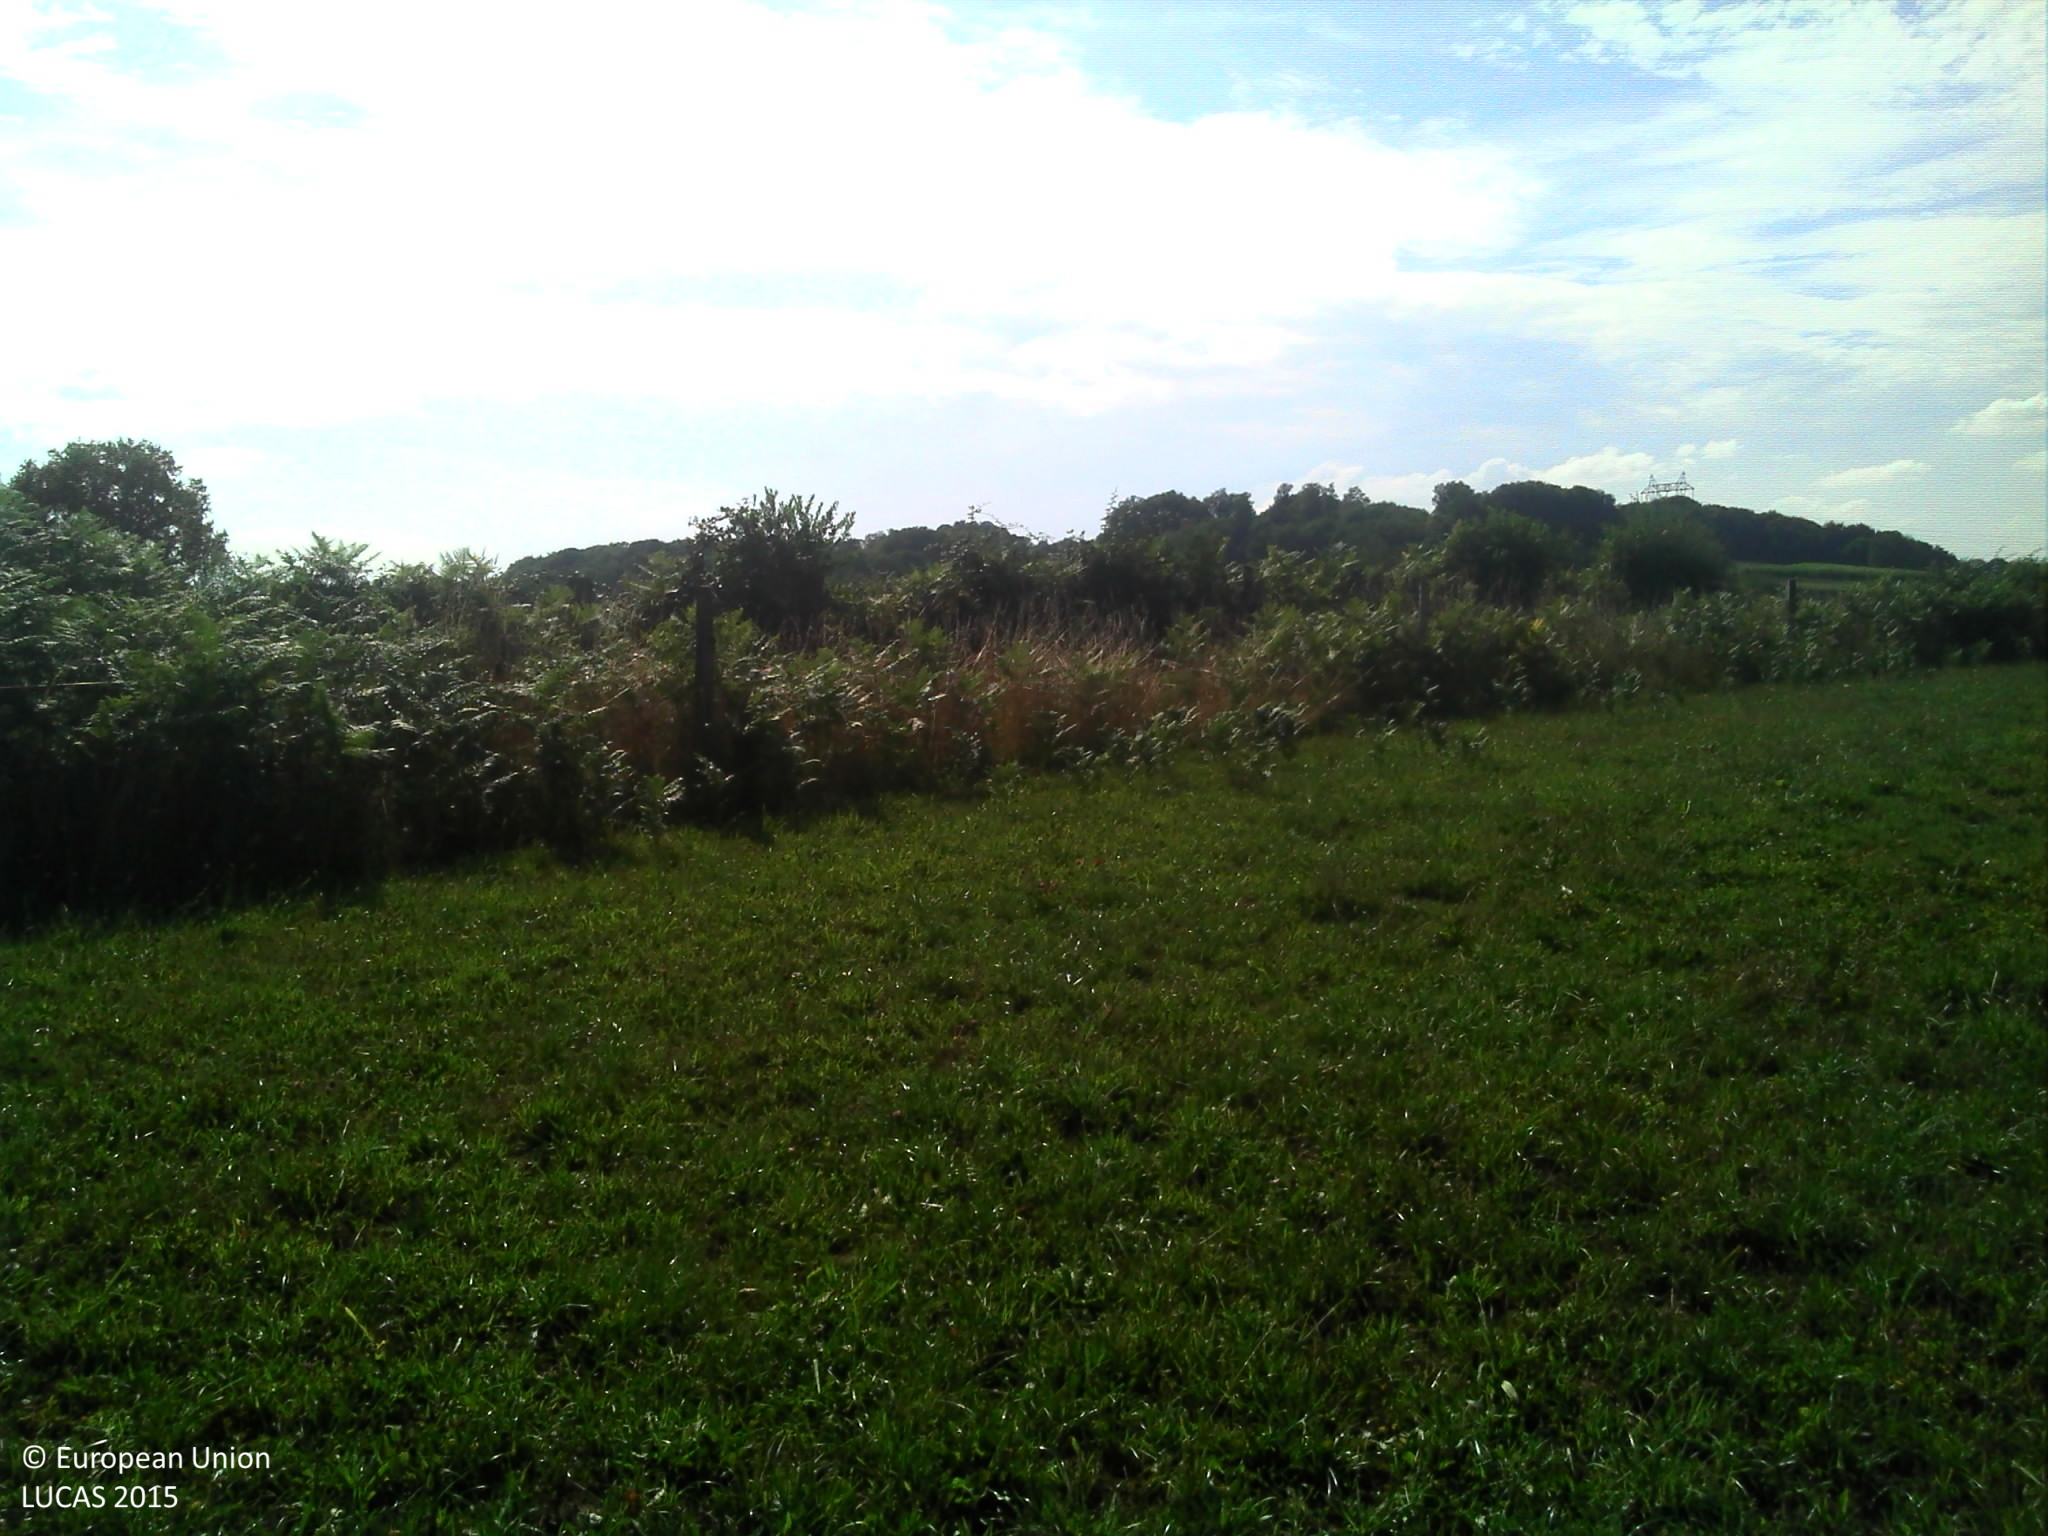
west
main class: Grassland
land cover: Grassland without tree/shrub cover
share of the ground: > 75 %
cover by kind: herbaceous plants 100 %
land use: Agriculture (excluding fallow land and kitchen gardens)
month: August
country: FR
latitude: 46.1424
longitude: 1.7721
